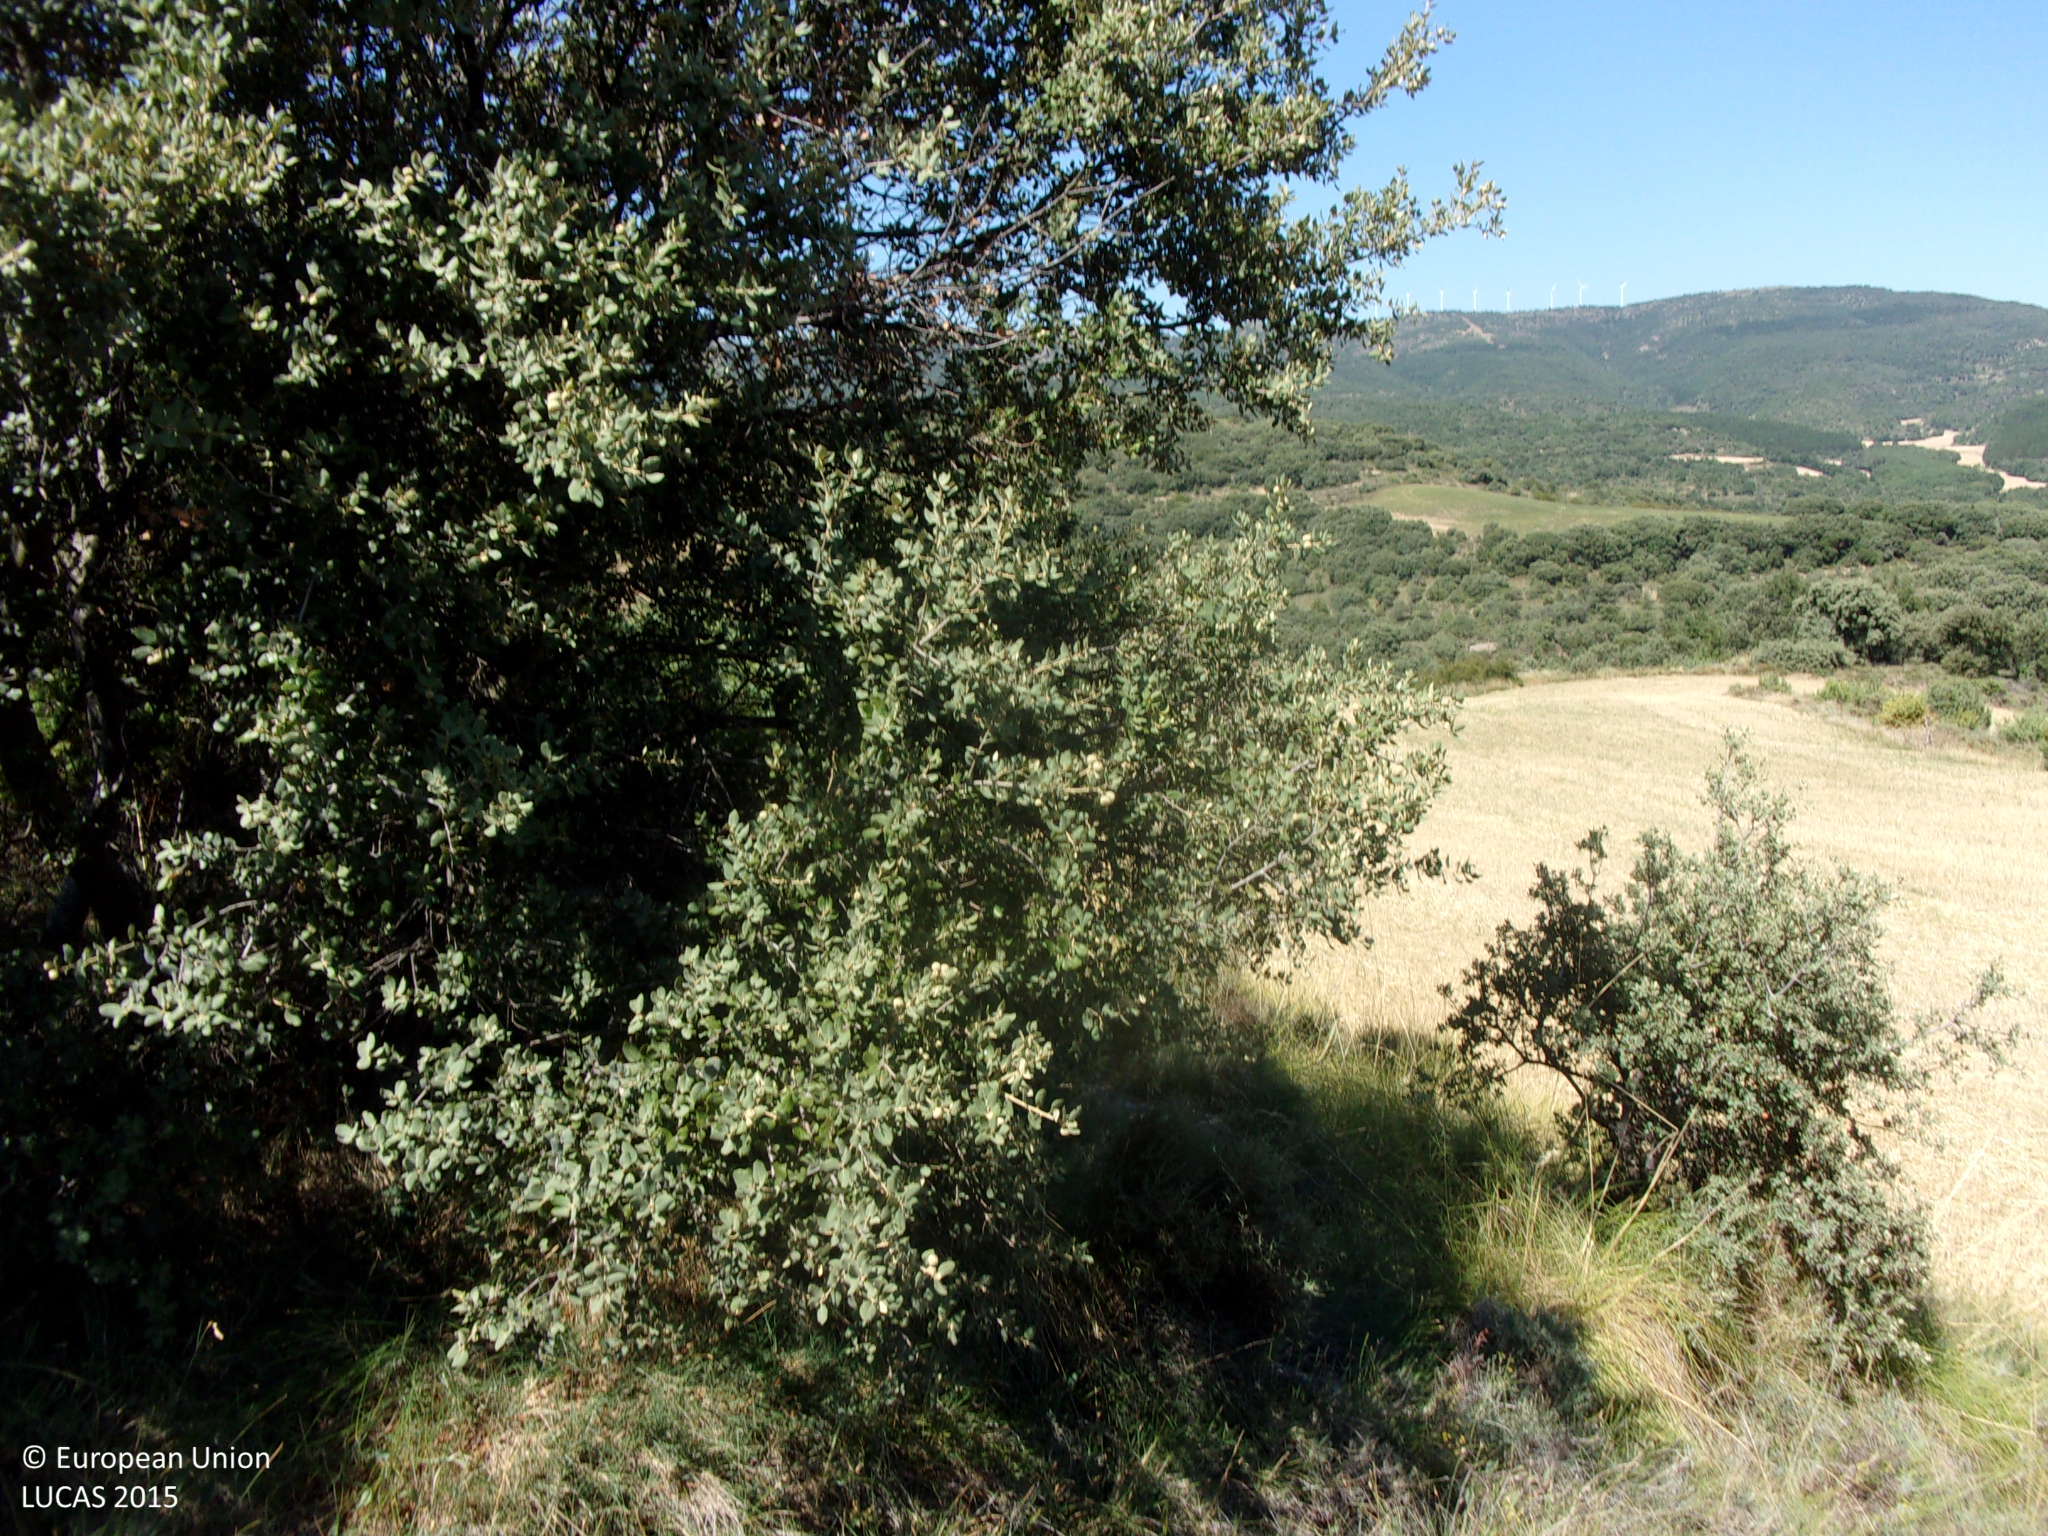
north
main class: Grassland
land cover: Grassland with sparse tree/shrub cover
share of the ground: > 75 %
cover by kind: herbaceous plants 85 %, shrubs 10 %, broadleaved forest trees 5 %
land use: Semi-natural and natural areas not in use
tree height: < 5 m
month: August
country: ES
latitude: 42.4063
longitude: -1.0993
